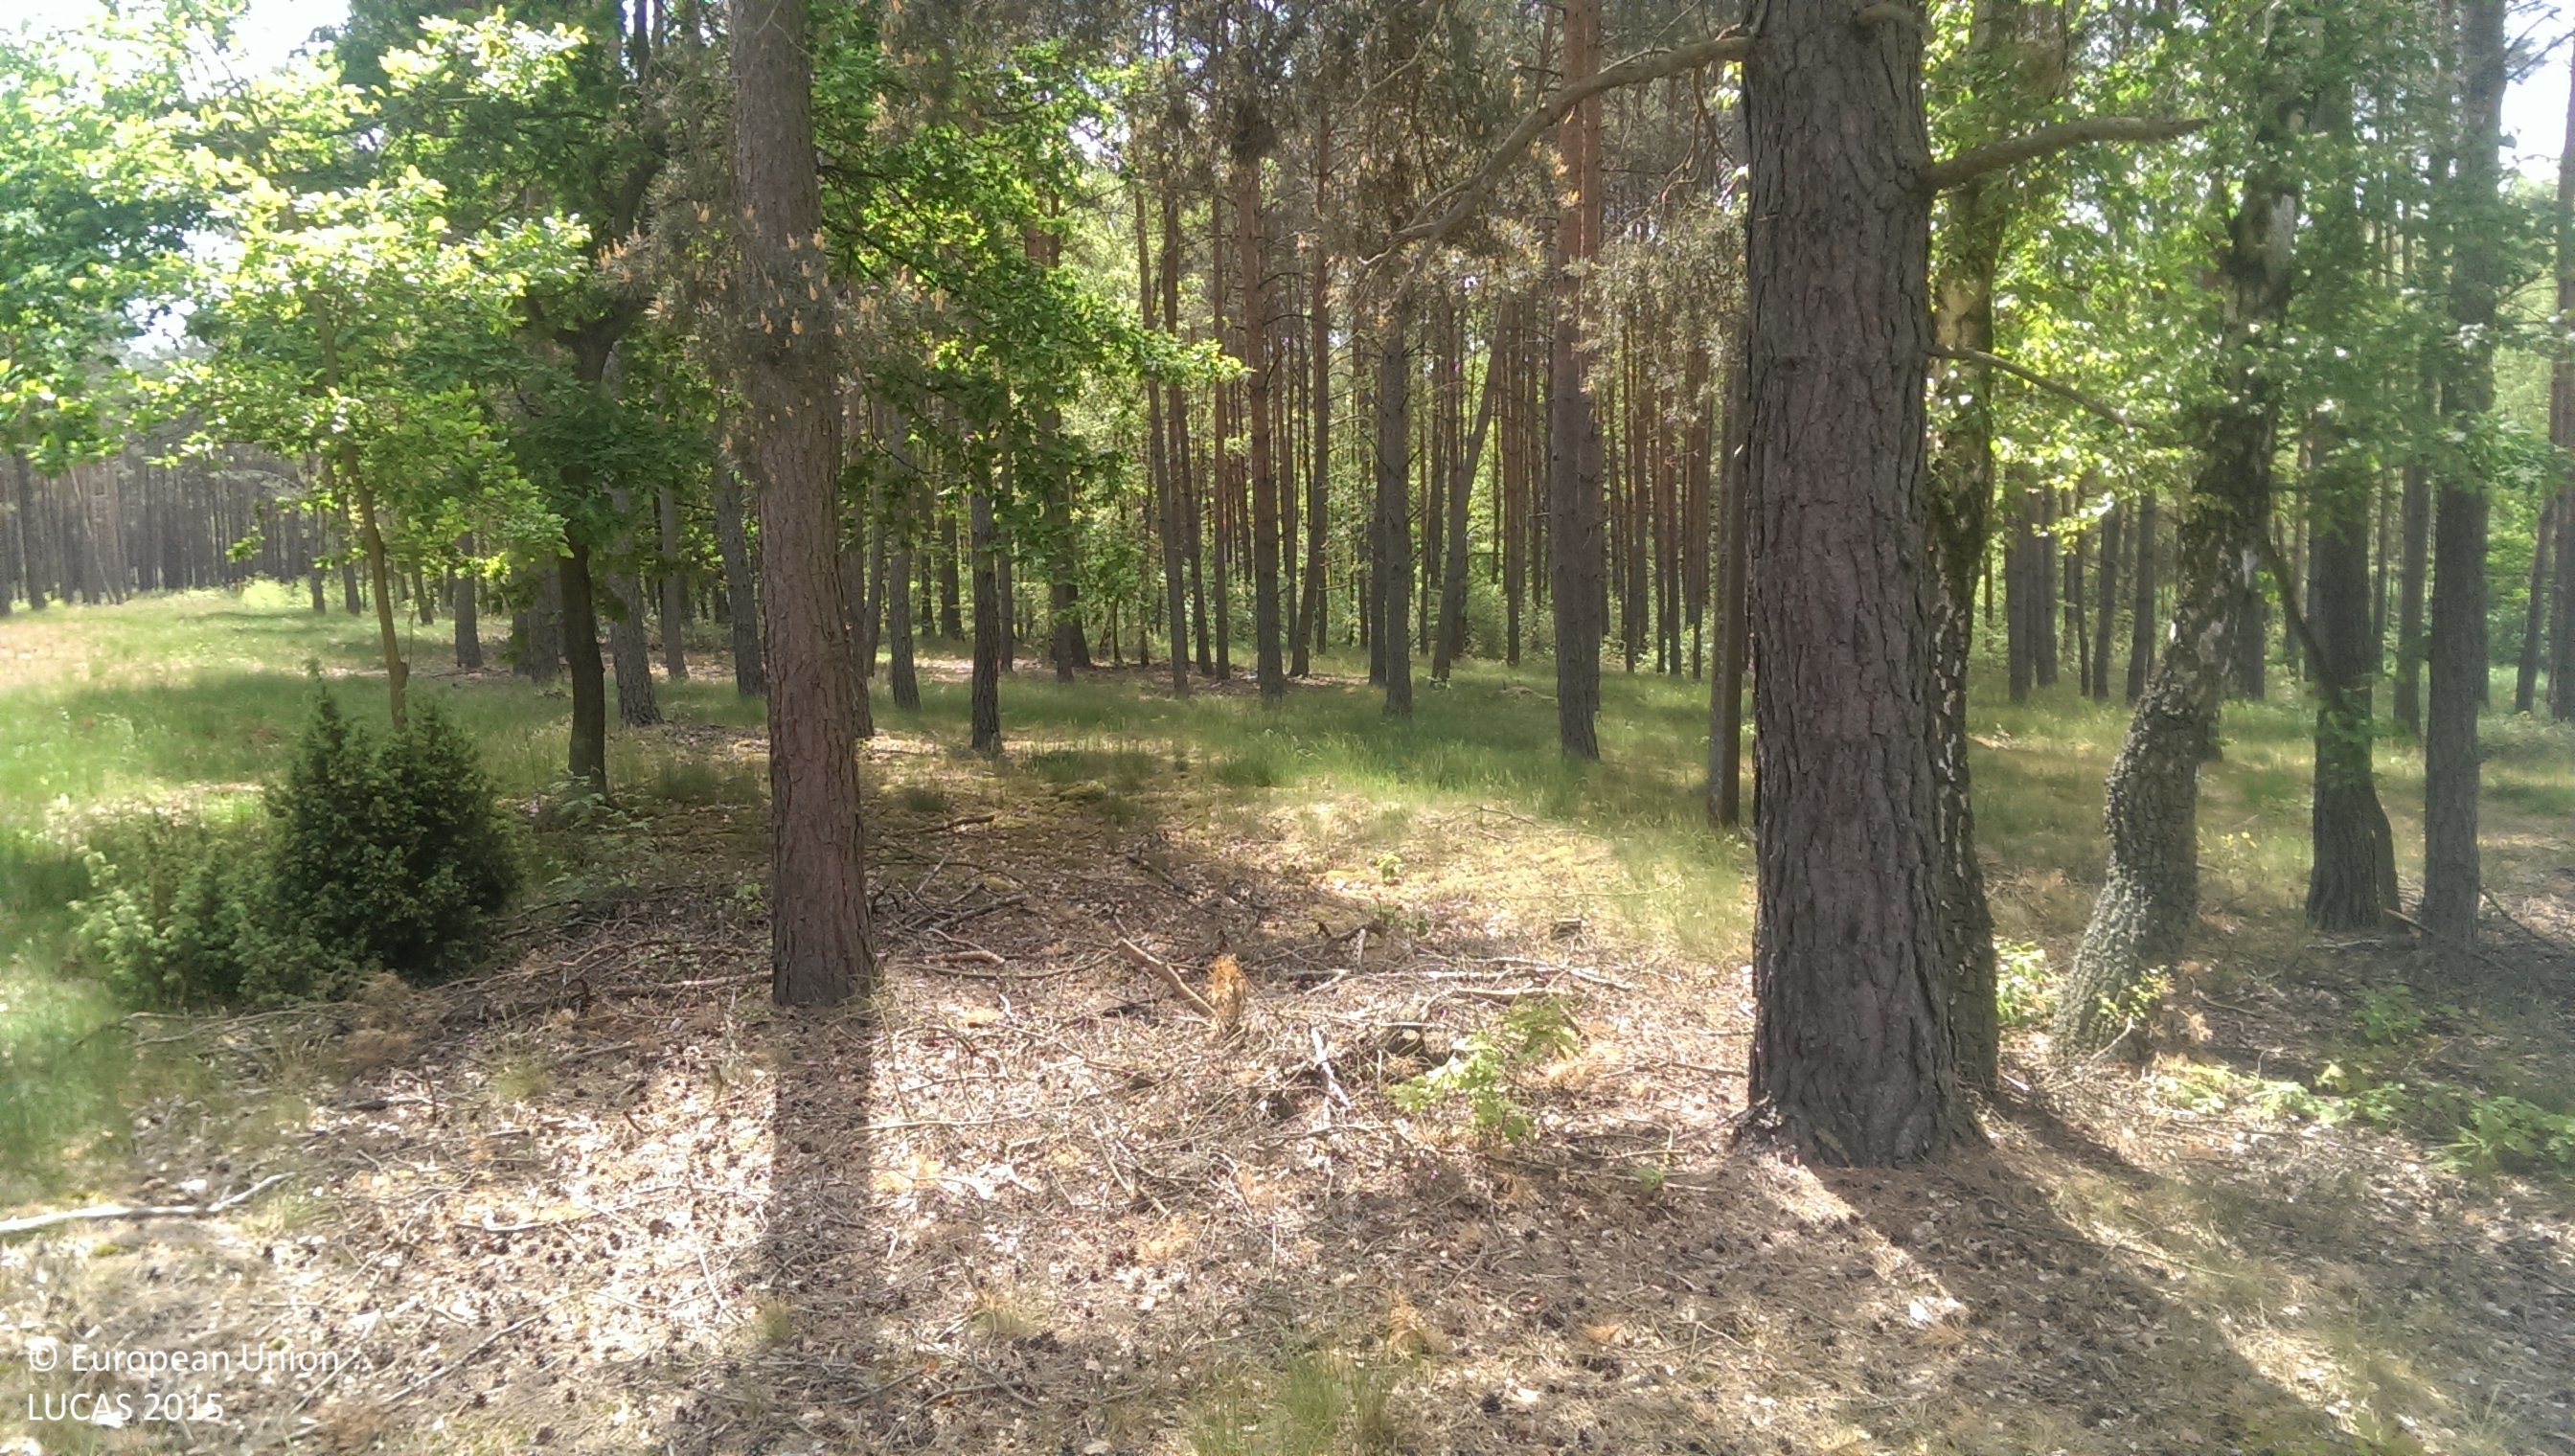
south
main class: Grassland
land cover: Grassland without tree/shrub cover
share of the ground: > 75 %
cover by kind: herbaceous plants 85 %, unconsolidated bare surface 15 %
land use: Residential
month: May
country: PL
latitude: 52.2335
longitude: 16.2001
